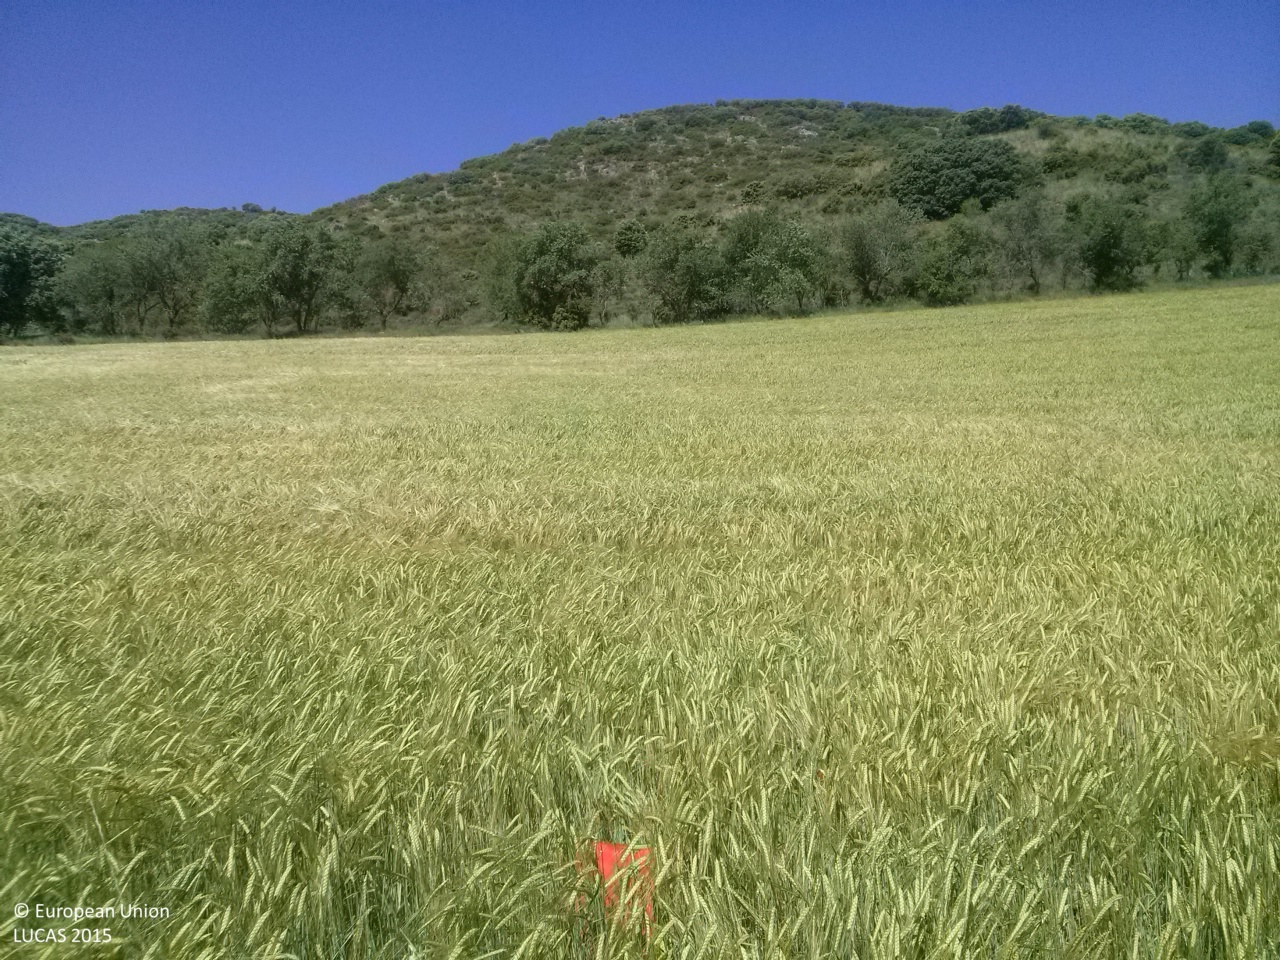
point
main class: Cropland
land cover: Barley
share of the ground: > 75 %
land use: Agriculture (excluding fallow land and kitchen gardens)
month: May
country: ES
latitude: 40.1736
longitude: -2.8119
